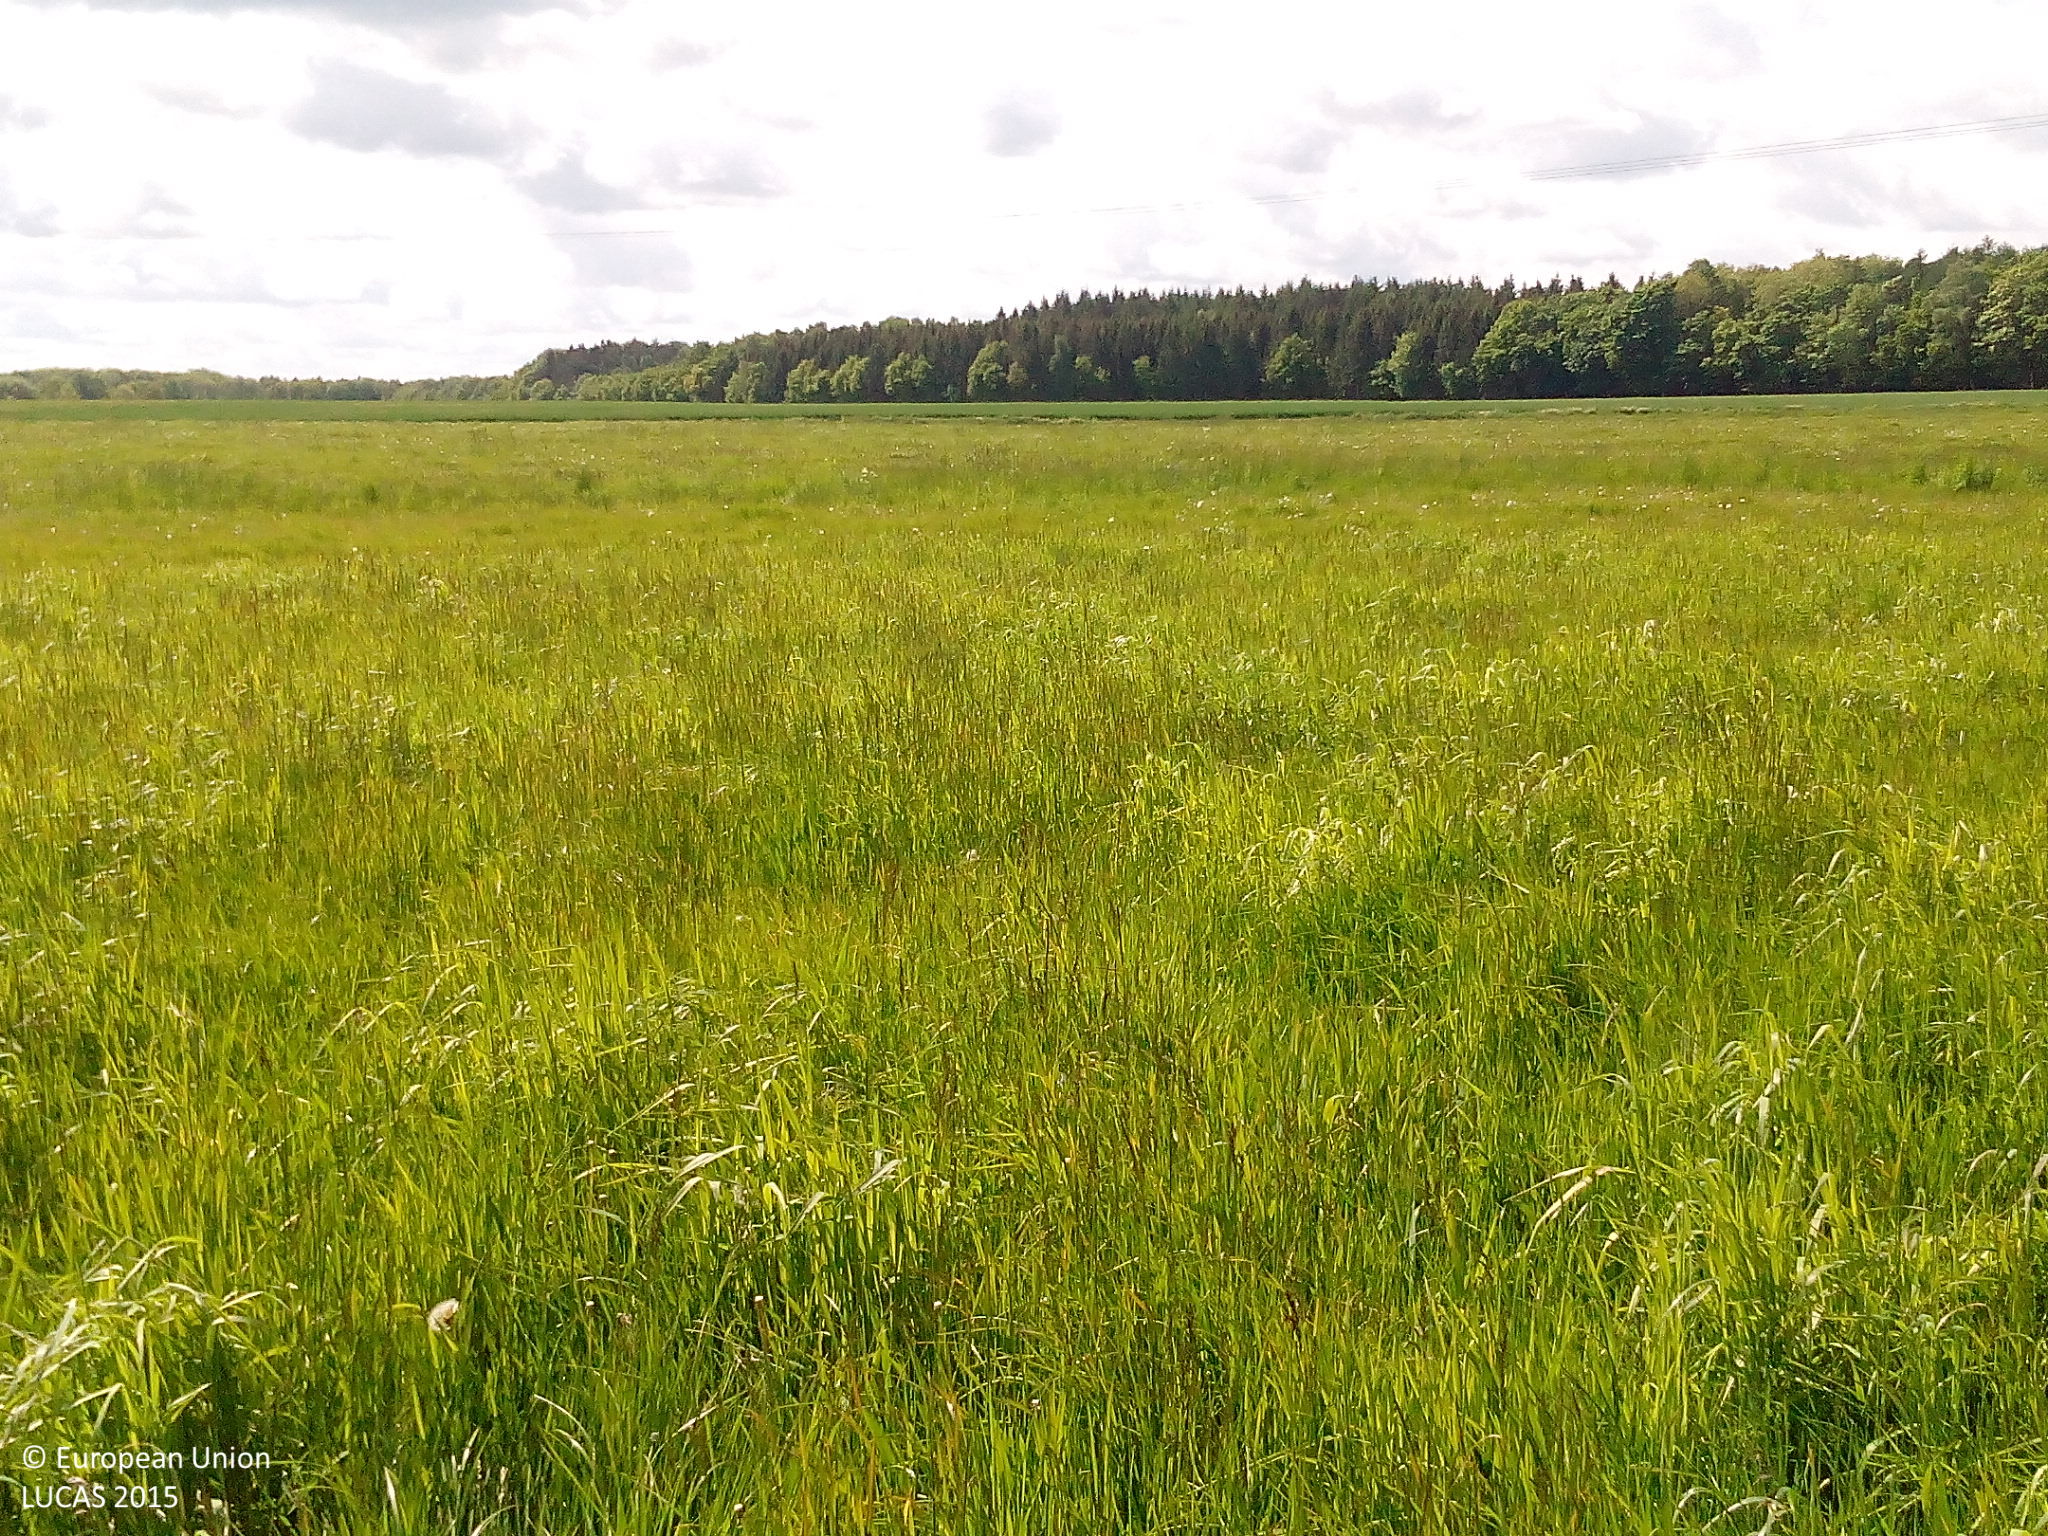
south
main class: Grassland
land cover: Grassland without tree/shrub cover
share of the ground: > 75 %
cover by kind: herbaceous plants 100 %
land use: Agriculture (excluding fallow land and kitchen gardens)
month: May
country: DE
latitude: 54.4539
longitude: 13.3153
